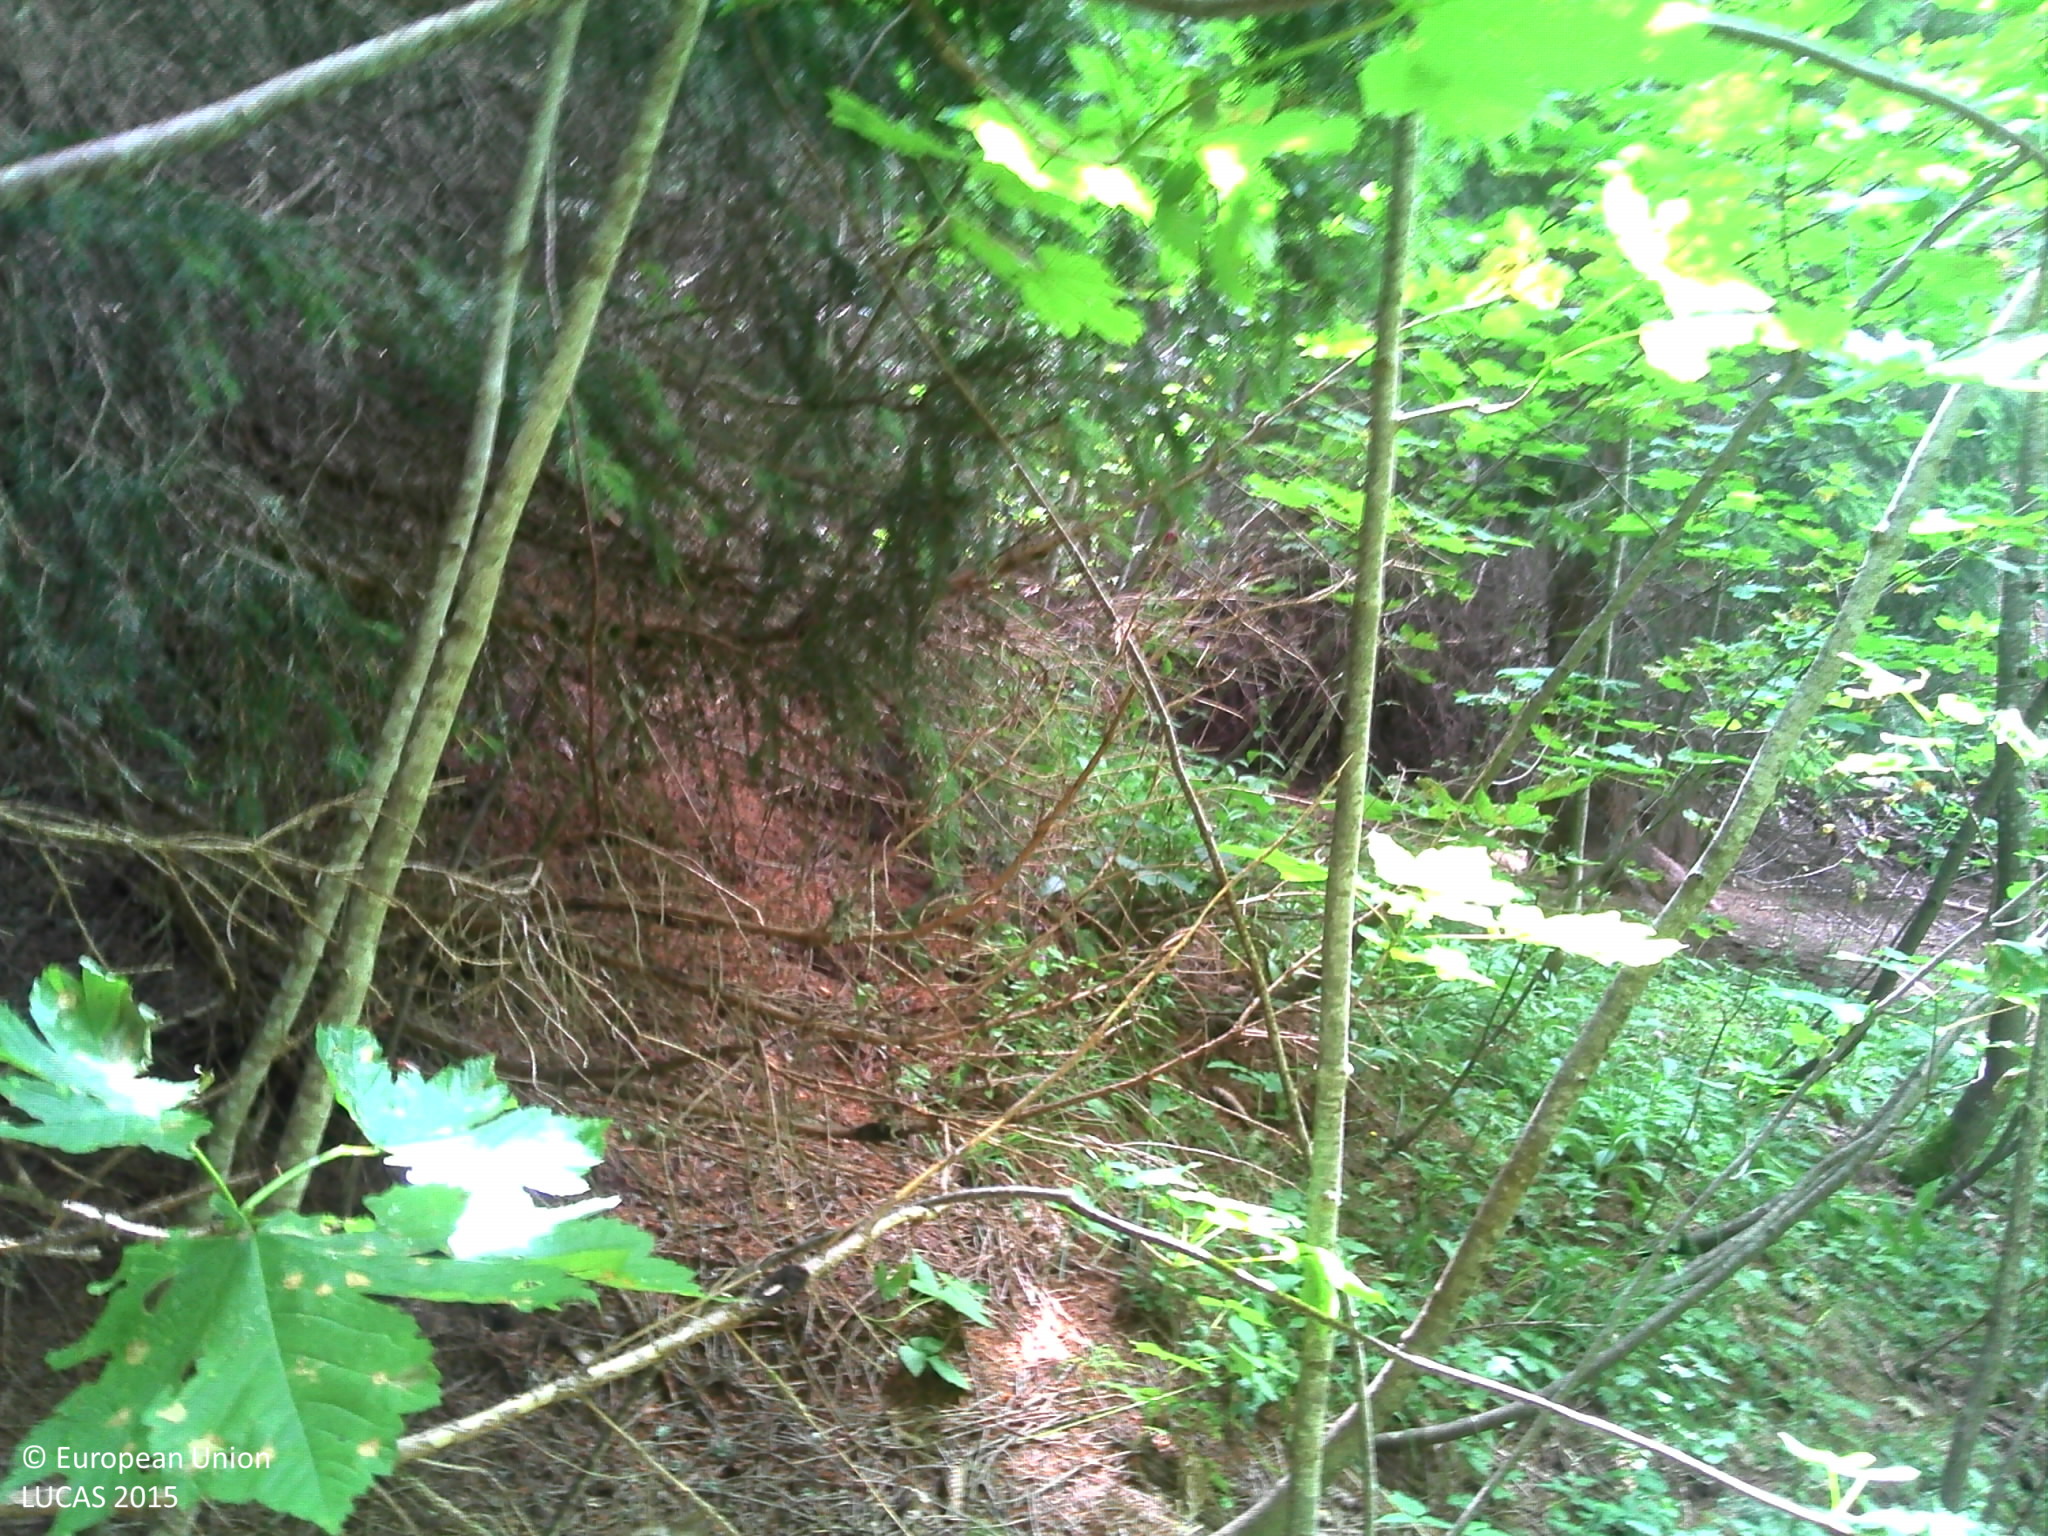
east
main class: Woodland
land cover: Spruce dominated coniferous woodland
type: alpine coniferous forest
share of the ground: > 75 %
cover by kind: coniferous forest trees 70 %, herbaceous plants 15 %, broadleaved forest trees 10 %, lichens and mosses 5 %
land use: Forestry
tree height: > 5 m
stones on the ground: < 10 %
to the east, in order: Spruce dominated coniferous woodland; Tracks; Spruce dominated coniferous woodland; Tracks; Spruce dominated coniferous woodland; Tracks; Spruce dominated mixed woodland
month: July
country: FR
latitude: 45.9499
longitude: 6.4561
